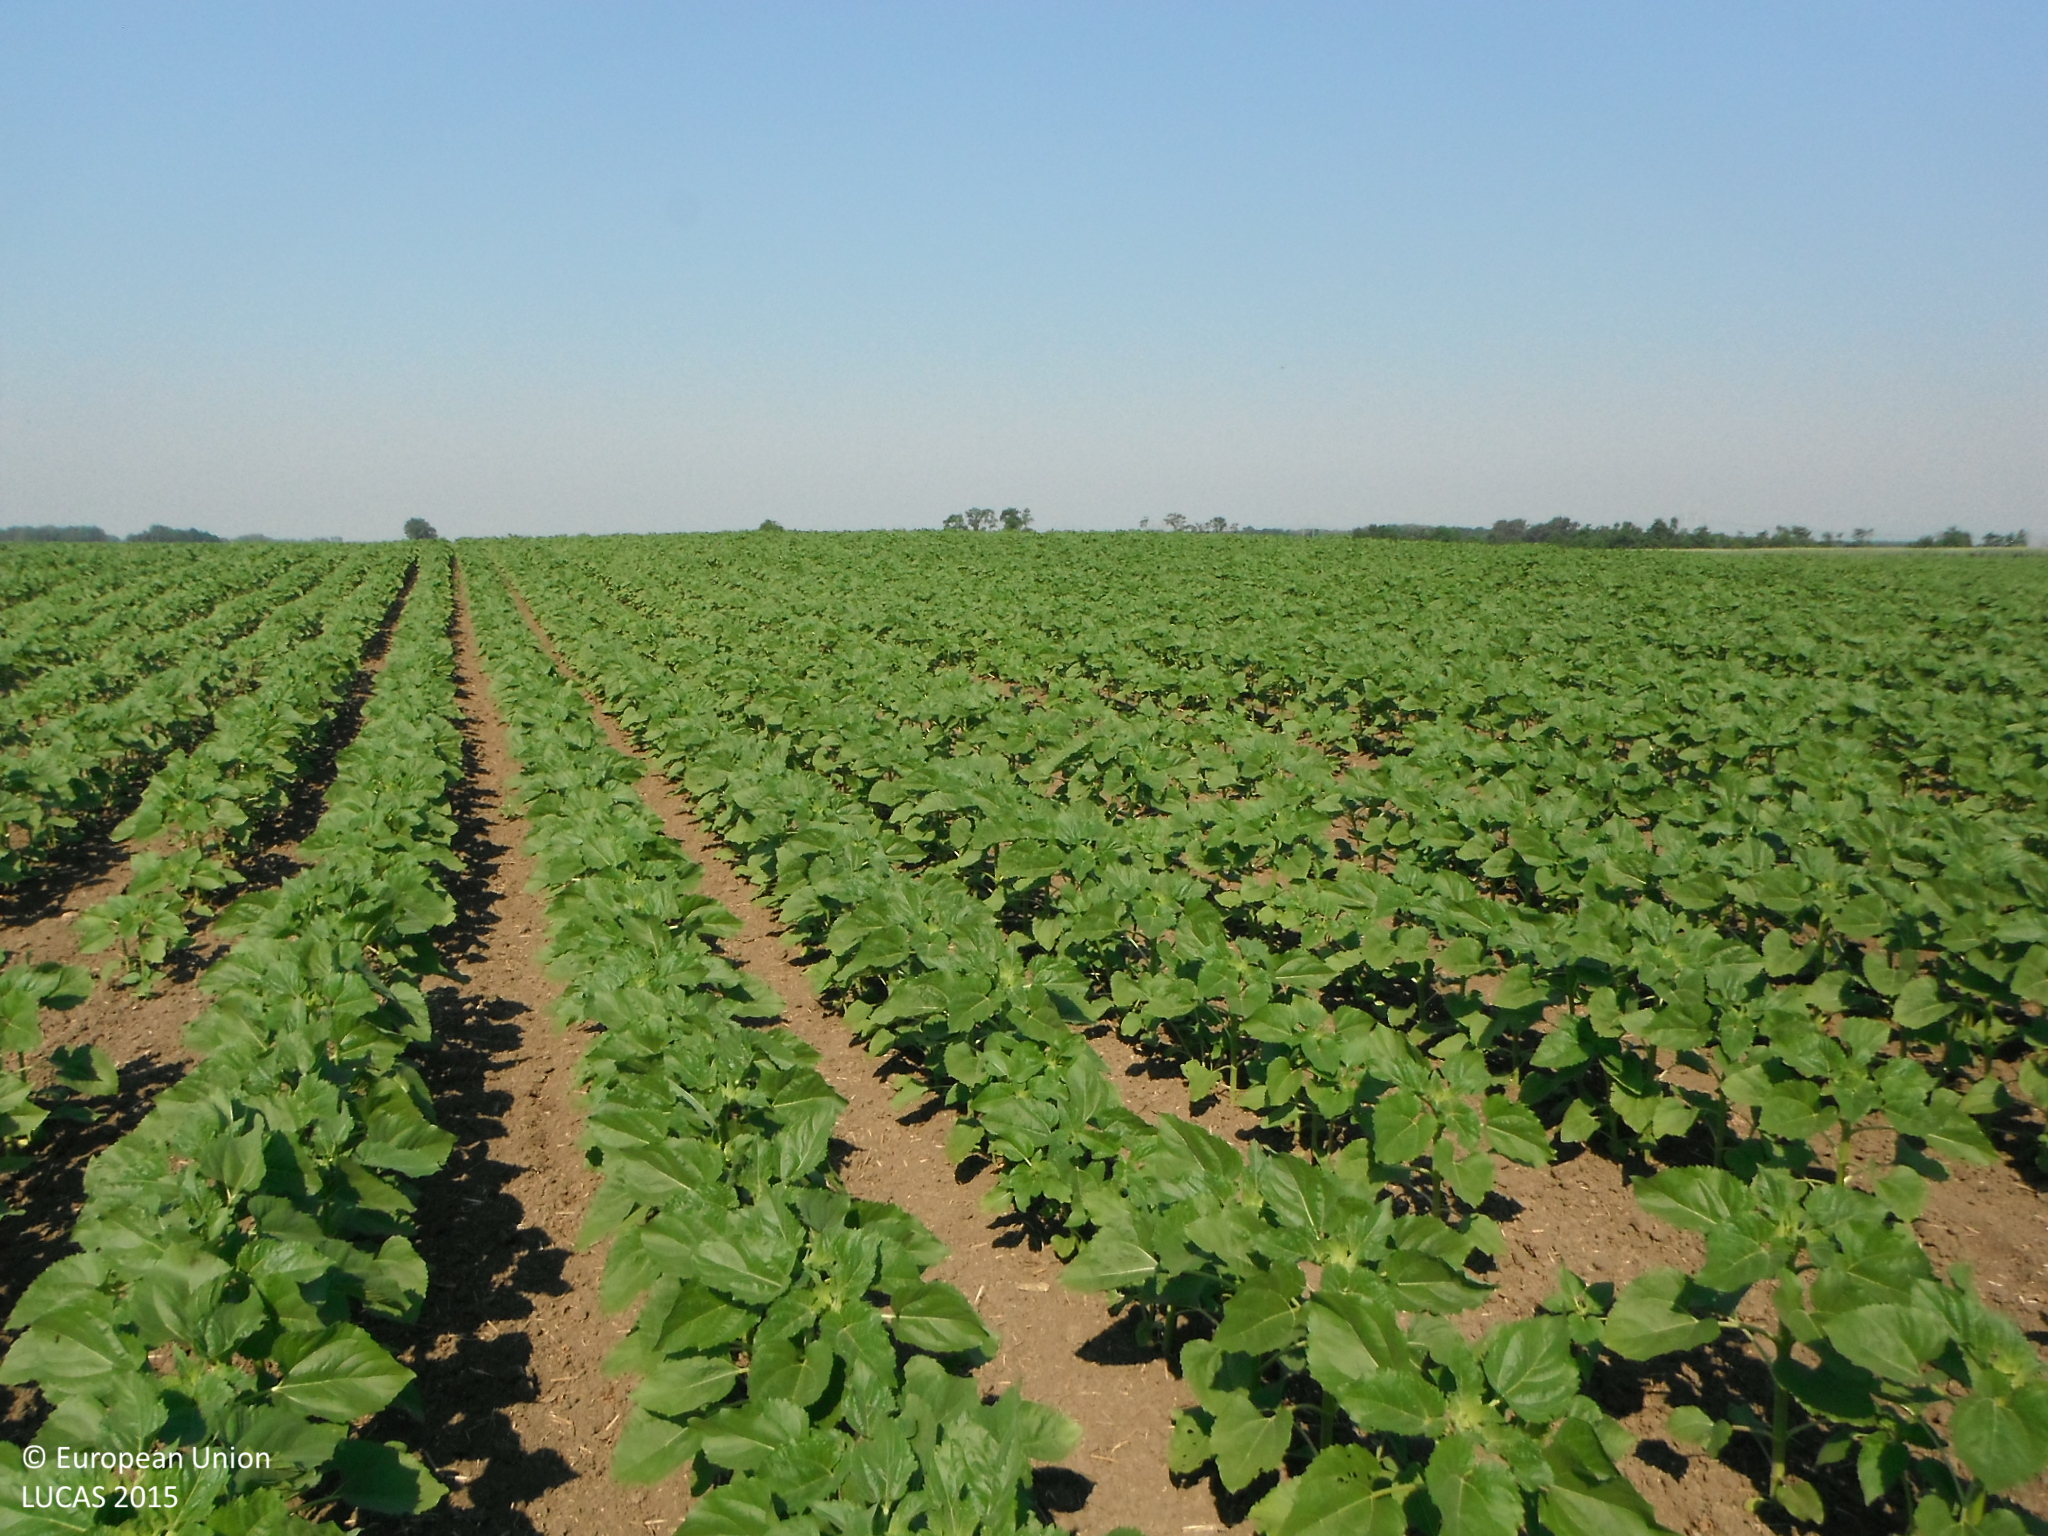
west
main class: Cropland
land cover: Sunflower
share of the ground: > 75 %
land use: Agriculture (excluding fallow land and kitchen gardens)
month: June
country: SK
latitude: 48.2808
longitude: 17.6788
